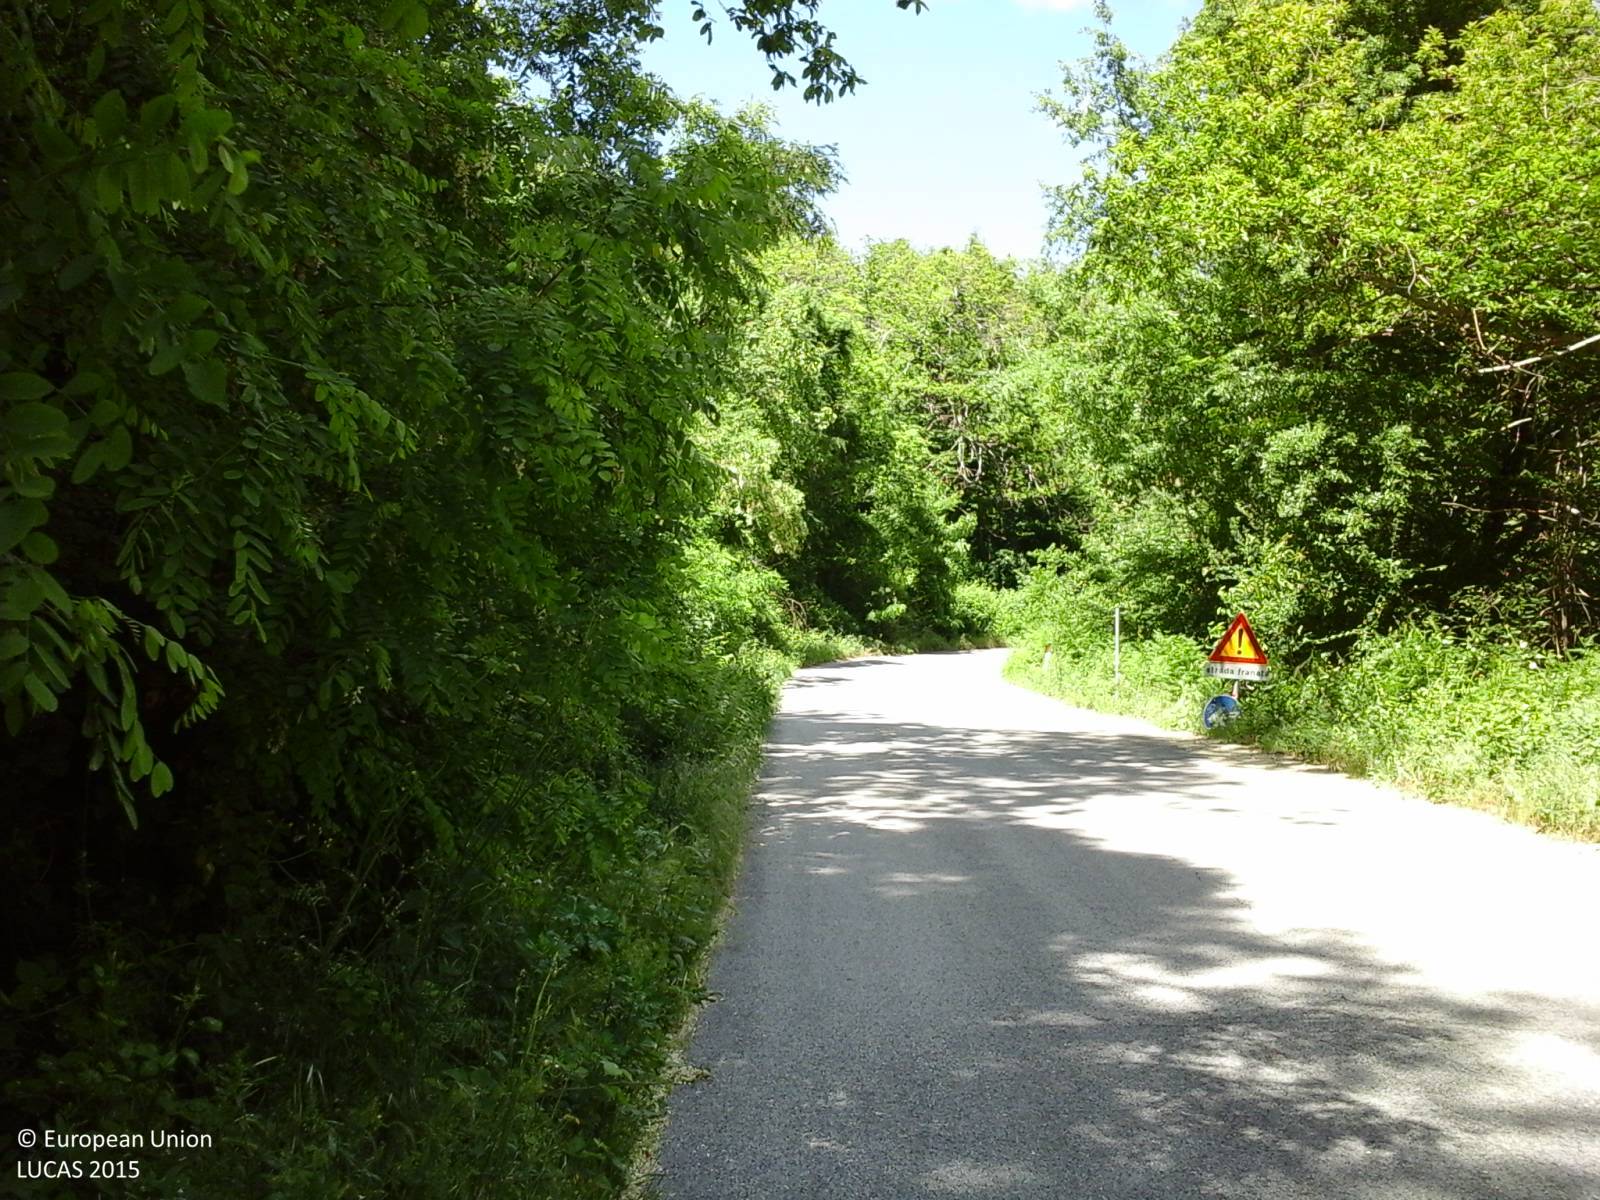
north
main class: Woodland
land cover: Broadleaved woodland
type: thermophilous deciduous forest
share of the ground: > 75 %
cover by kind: broadleaved forest trees 75 %, shrubs 15 %, herbaceous plants 10 %
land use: Forestry
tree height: > 5 m
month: May
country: IT
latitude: 42.1201
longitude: 13.0496
